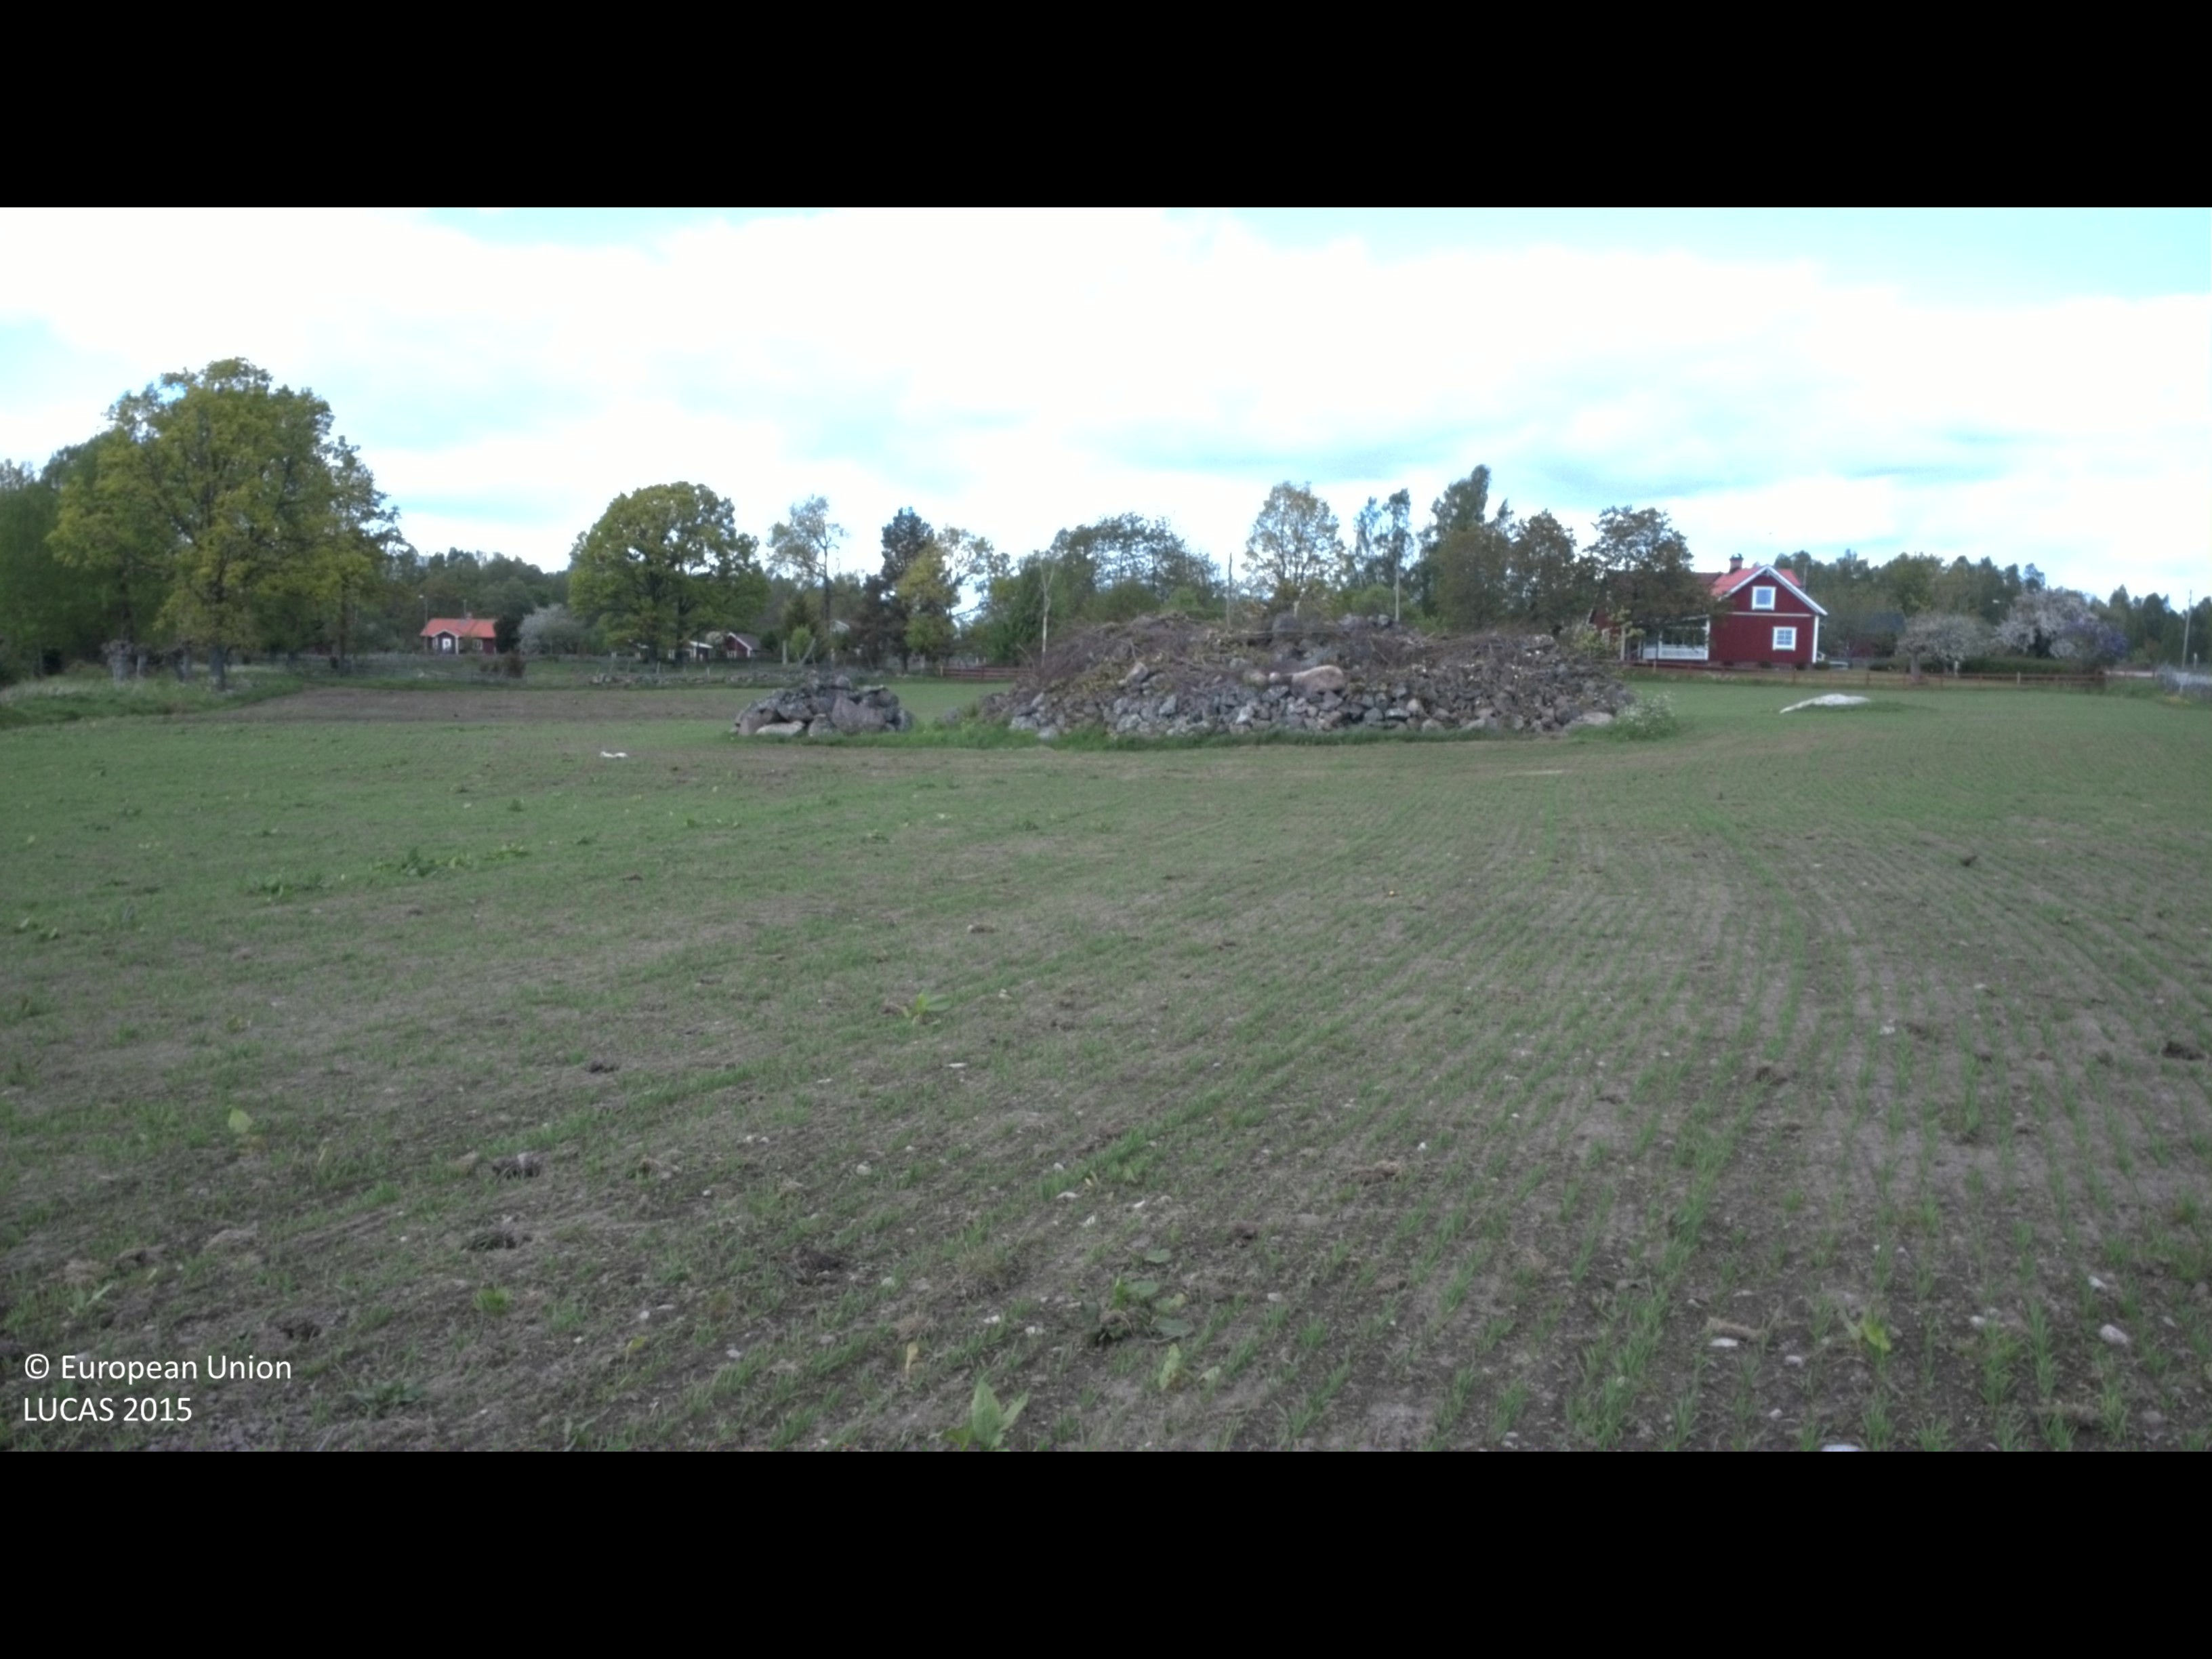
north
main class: Cropland
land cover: Temporary grasslands
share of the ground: < 10 %
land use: Agriculture (excluding fallow land and kitchen gardens)
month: May
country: SE
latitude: 57.3385
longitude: 16.1624
